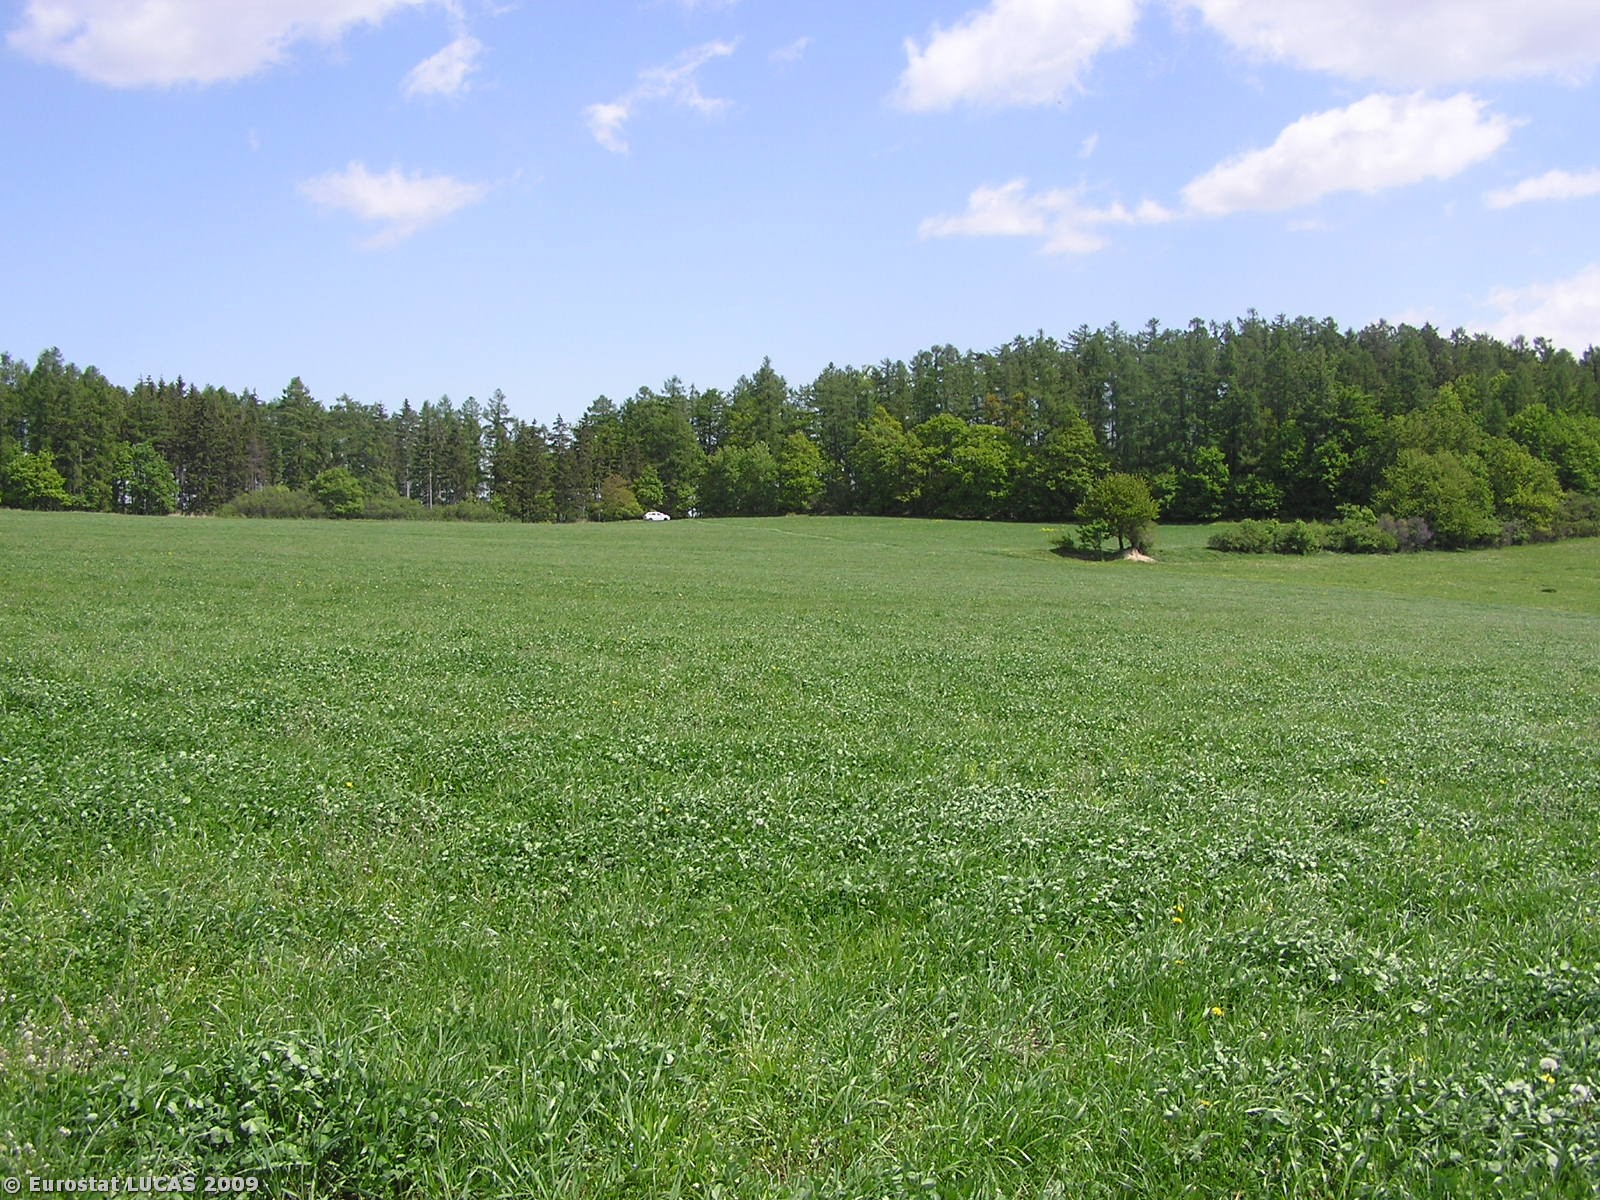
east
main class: Cropland
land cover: Clovers
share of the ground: > 75 %
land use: Agriculture (excluding fallow land and kitchen gardens)
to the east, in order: Clovers; Tracks; Clovers
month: May
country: CZ
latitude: 50.0194
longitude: 17.6195
